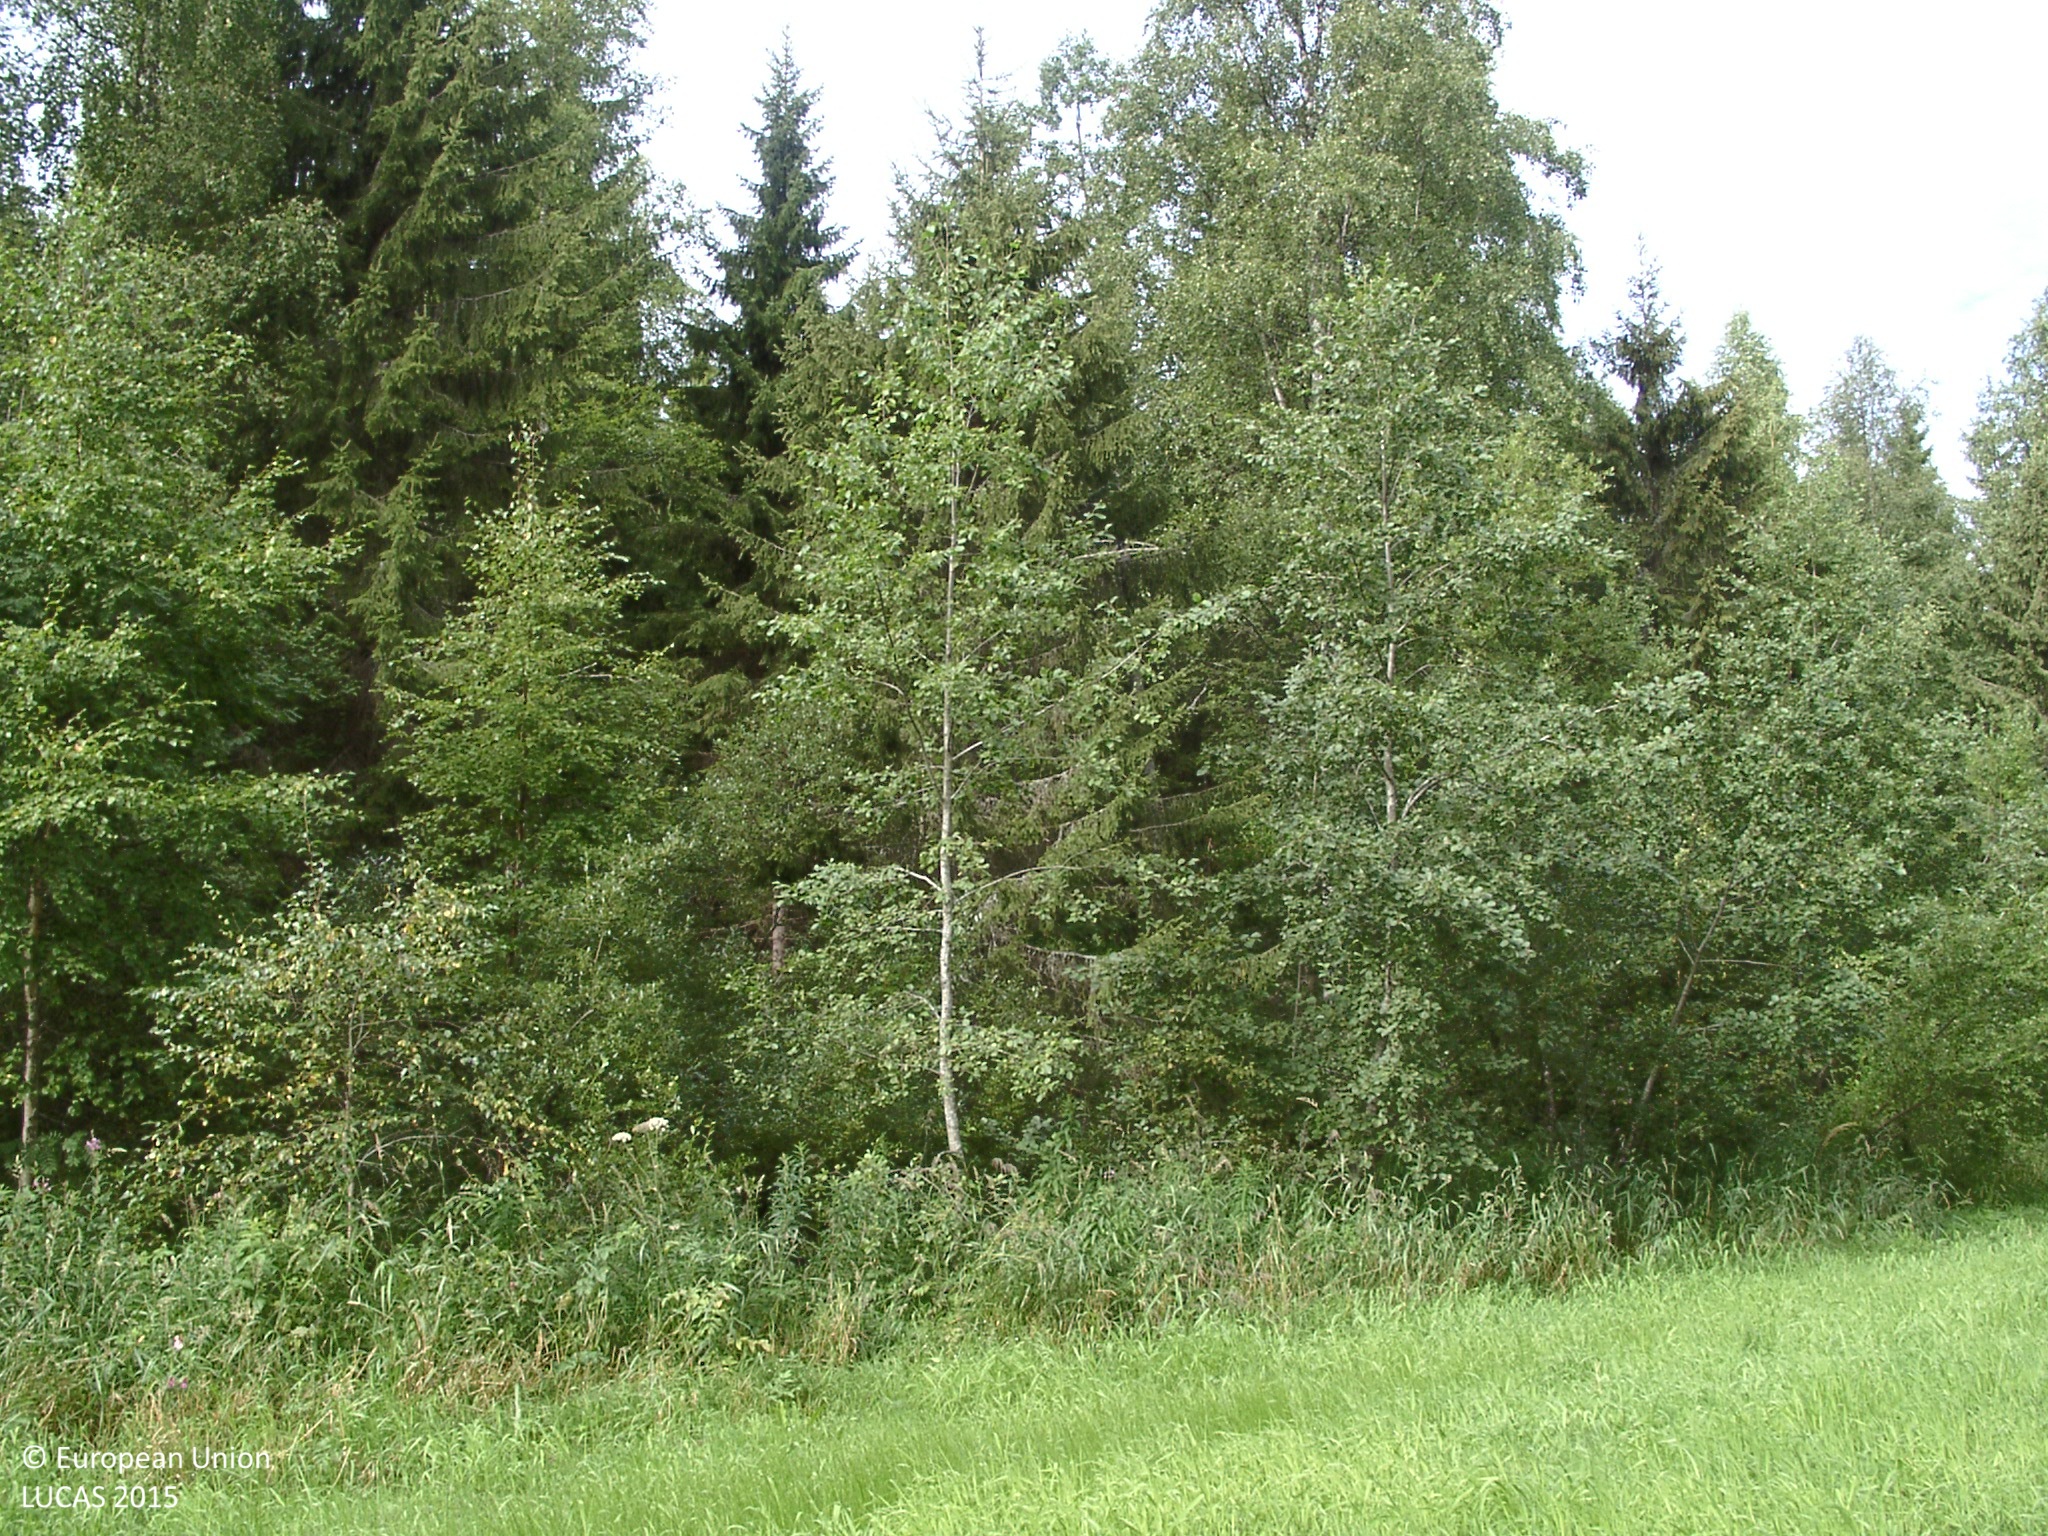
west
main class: Cropland
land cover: Temporary grasslands
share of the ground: > 75 %
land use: Agriculture (excluding fallow land and kitchen gardens)
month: August
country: FI
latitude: 62.4228
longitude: 25.3869
